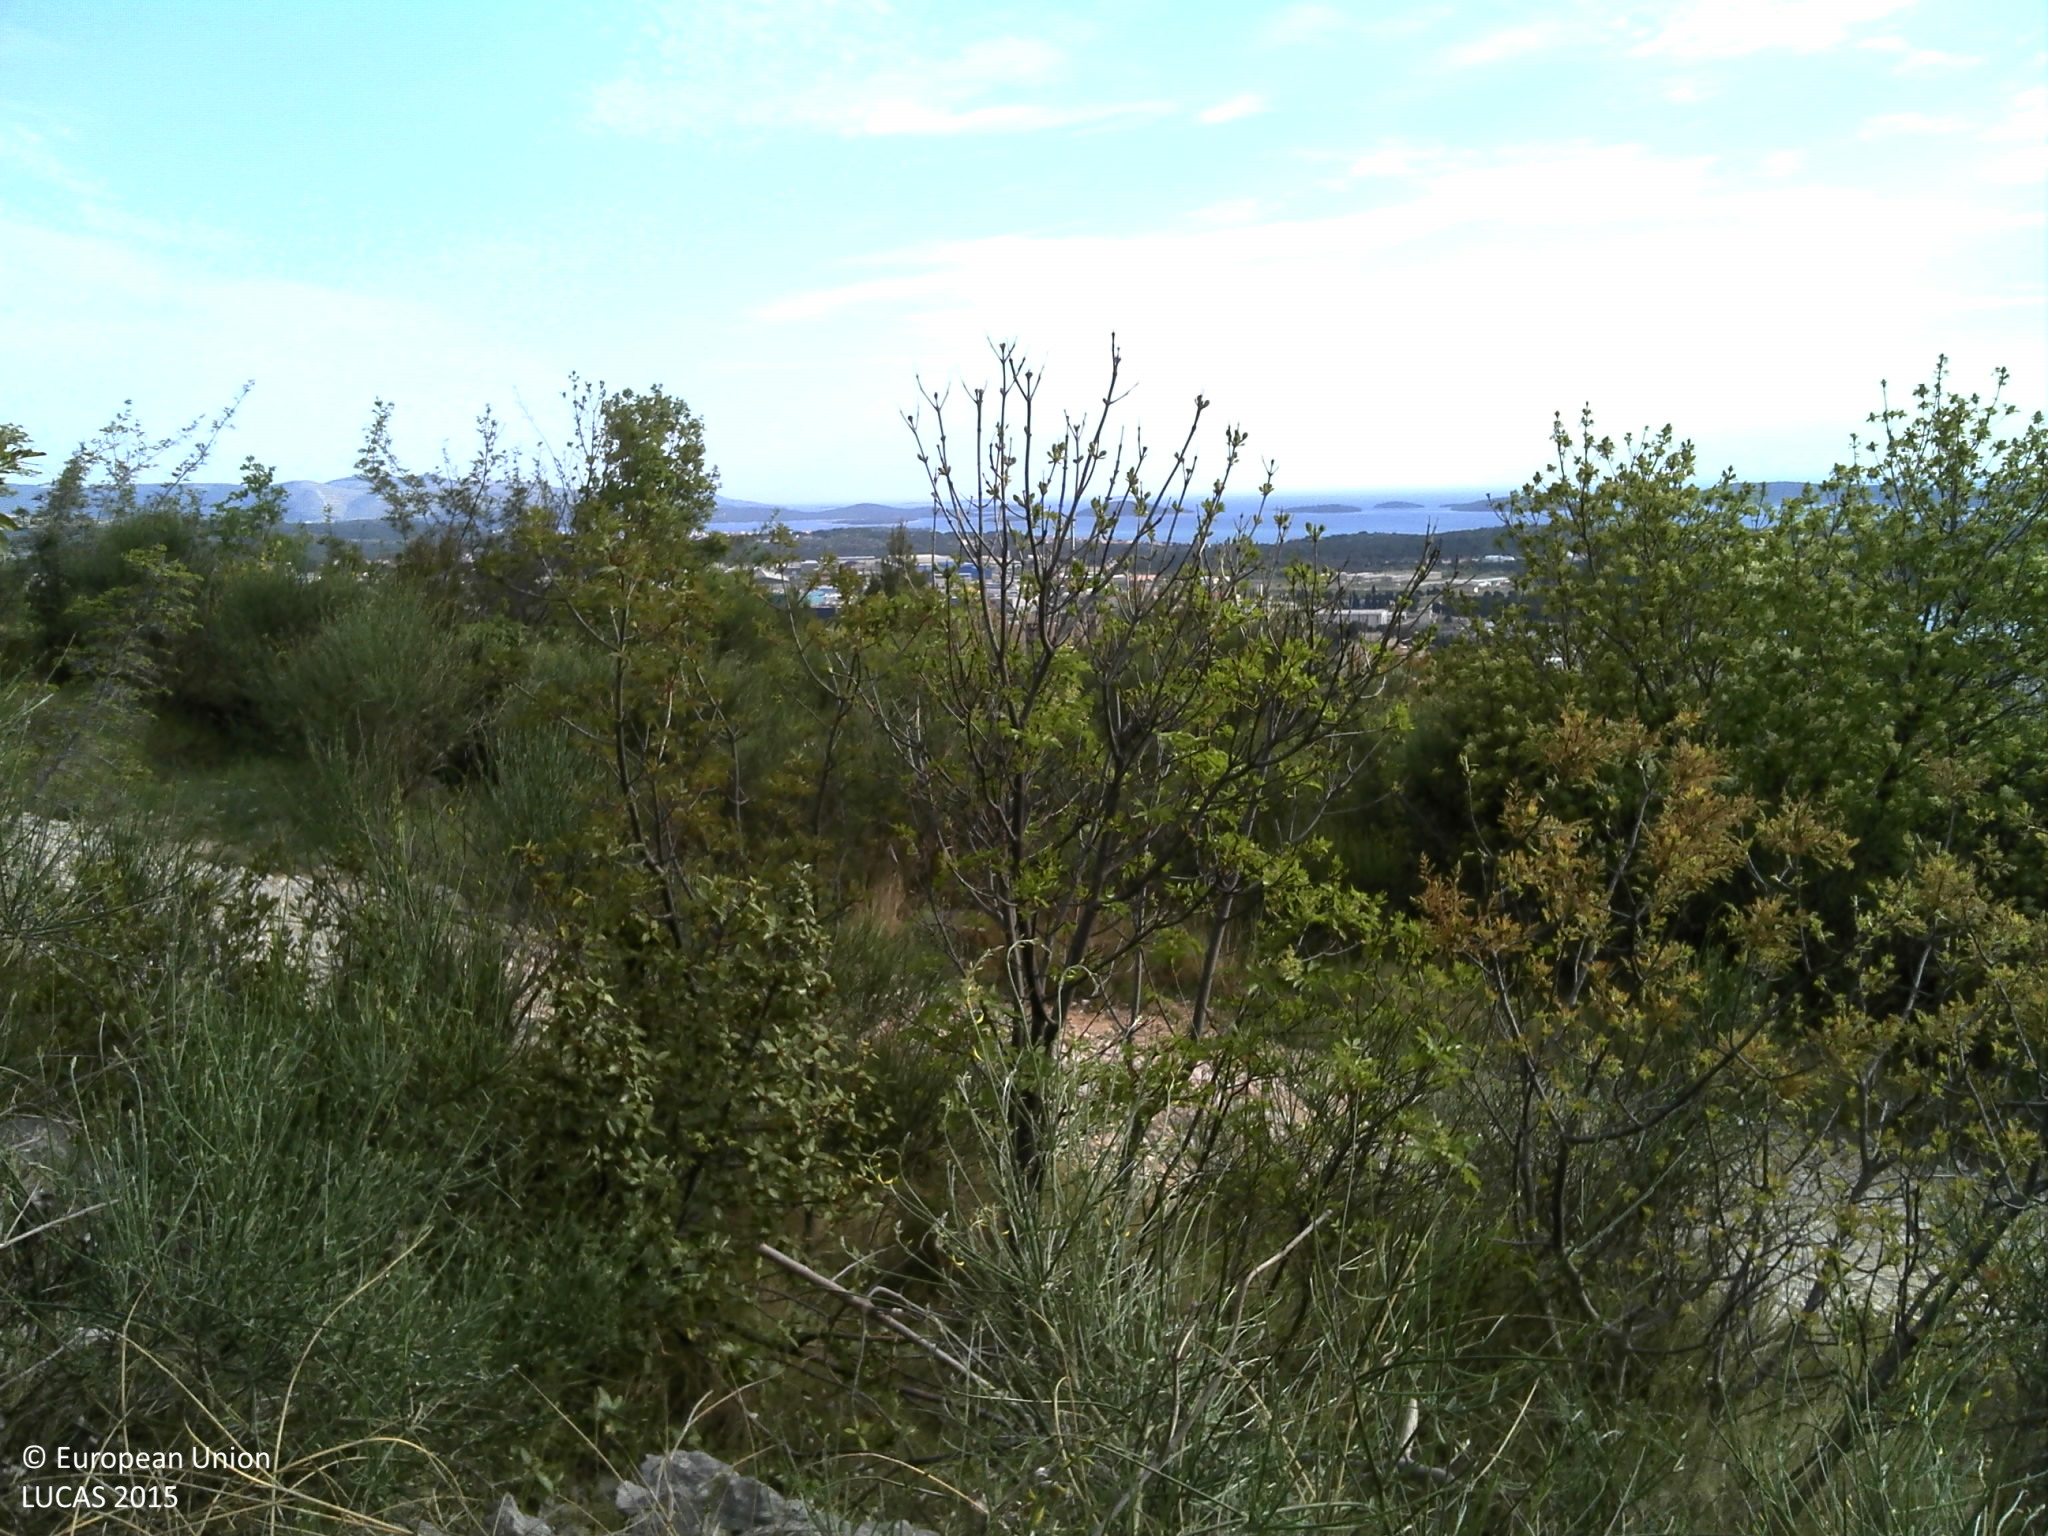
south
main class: Shrubland
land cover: Shrubland with sparse tree cover
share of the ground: 50 - 75 %
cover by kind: shrubs 65 %, herbaceous plants 20 %, unconsolidated bare surface 10 %, broadleaved forest trees 5 %
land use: Semi-natural and natural areas not in use
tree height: < 5 m
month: April
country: HR
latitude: 43.7298
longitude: 15.9129
